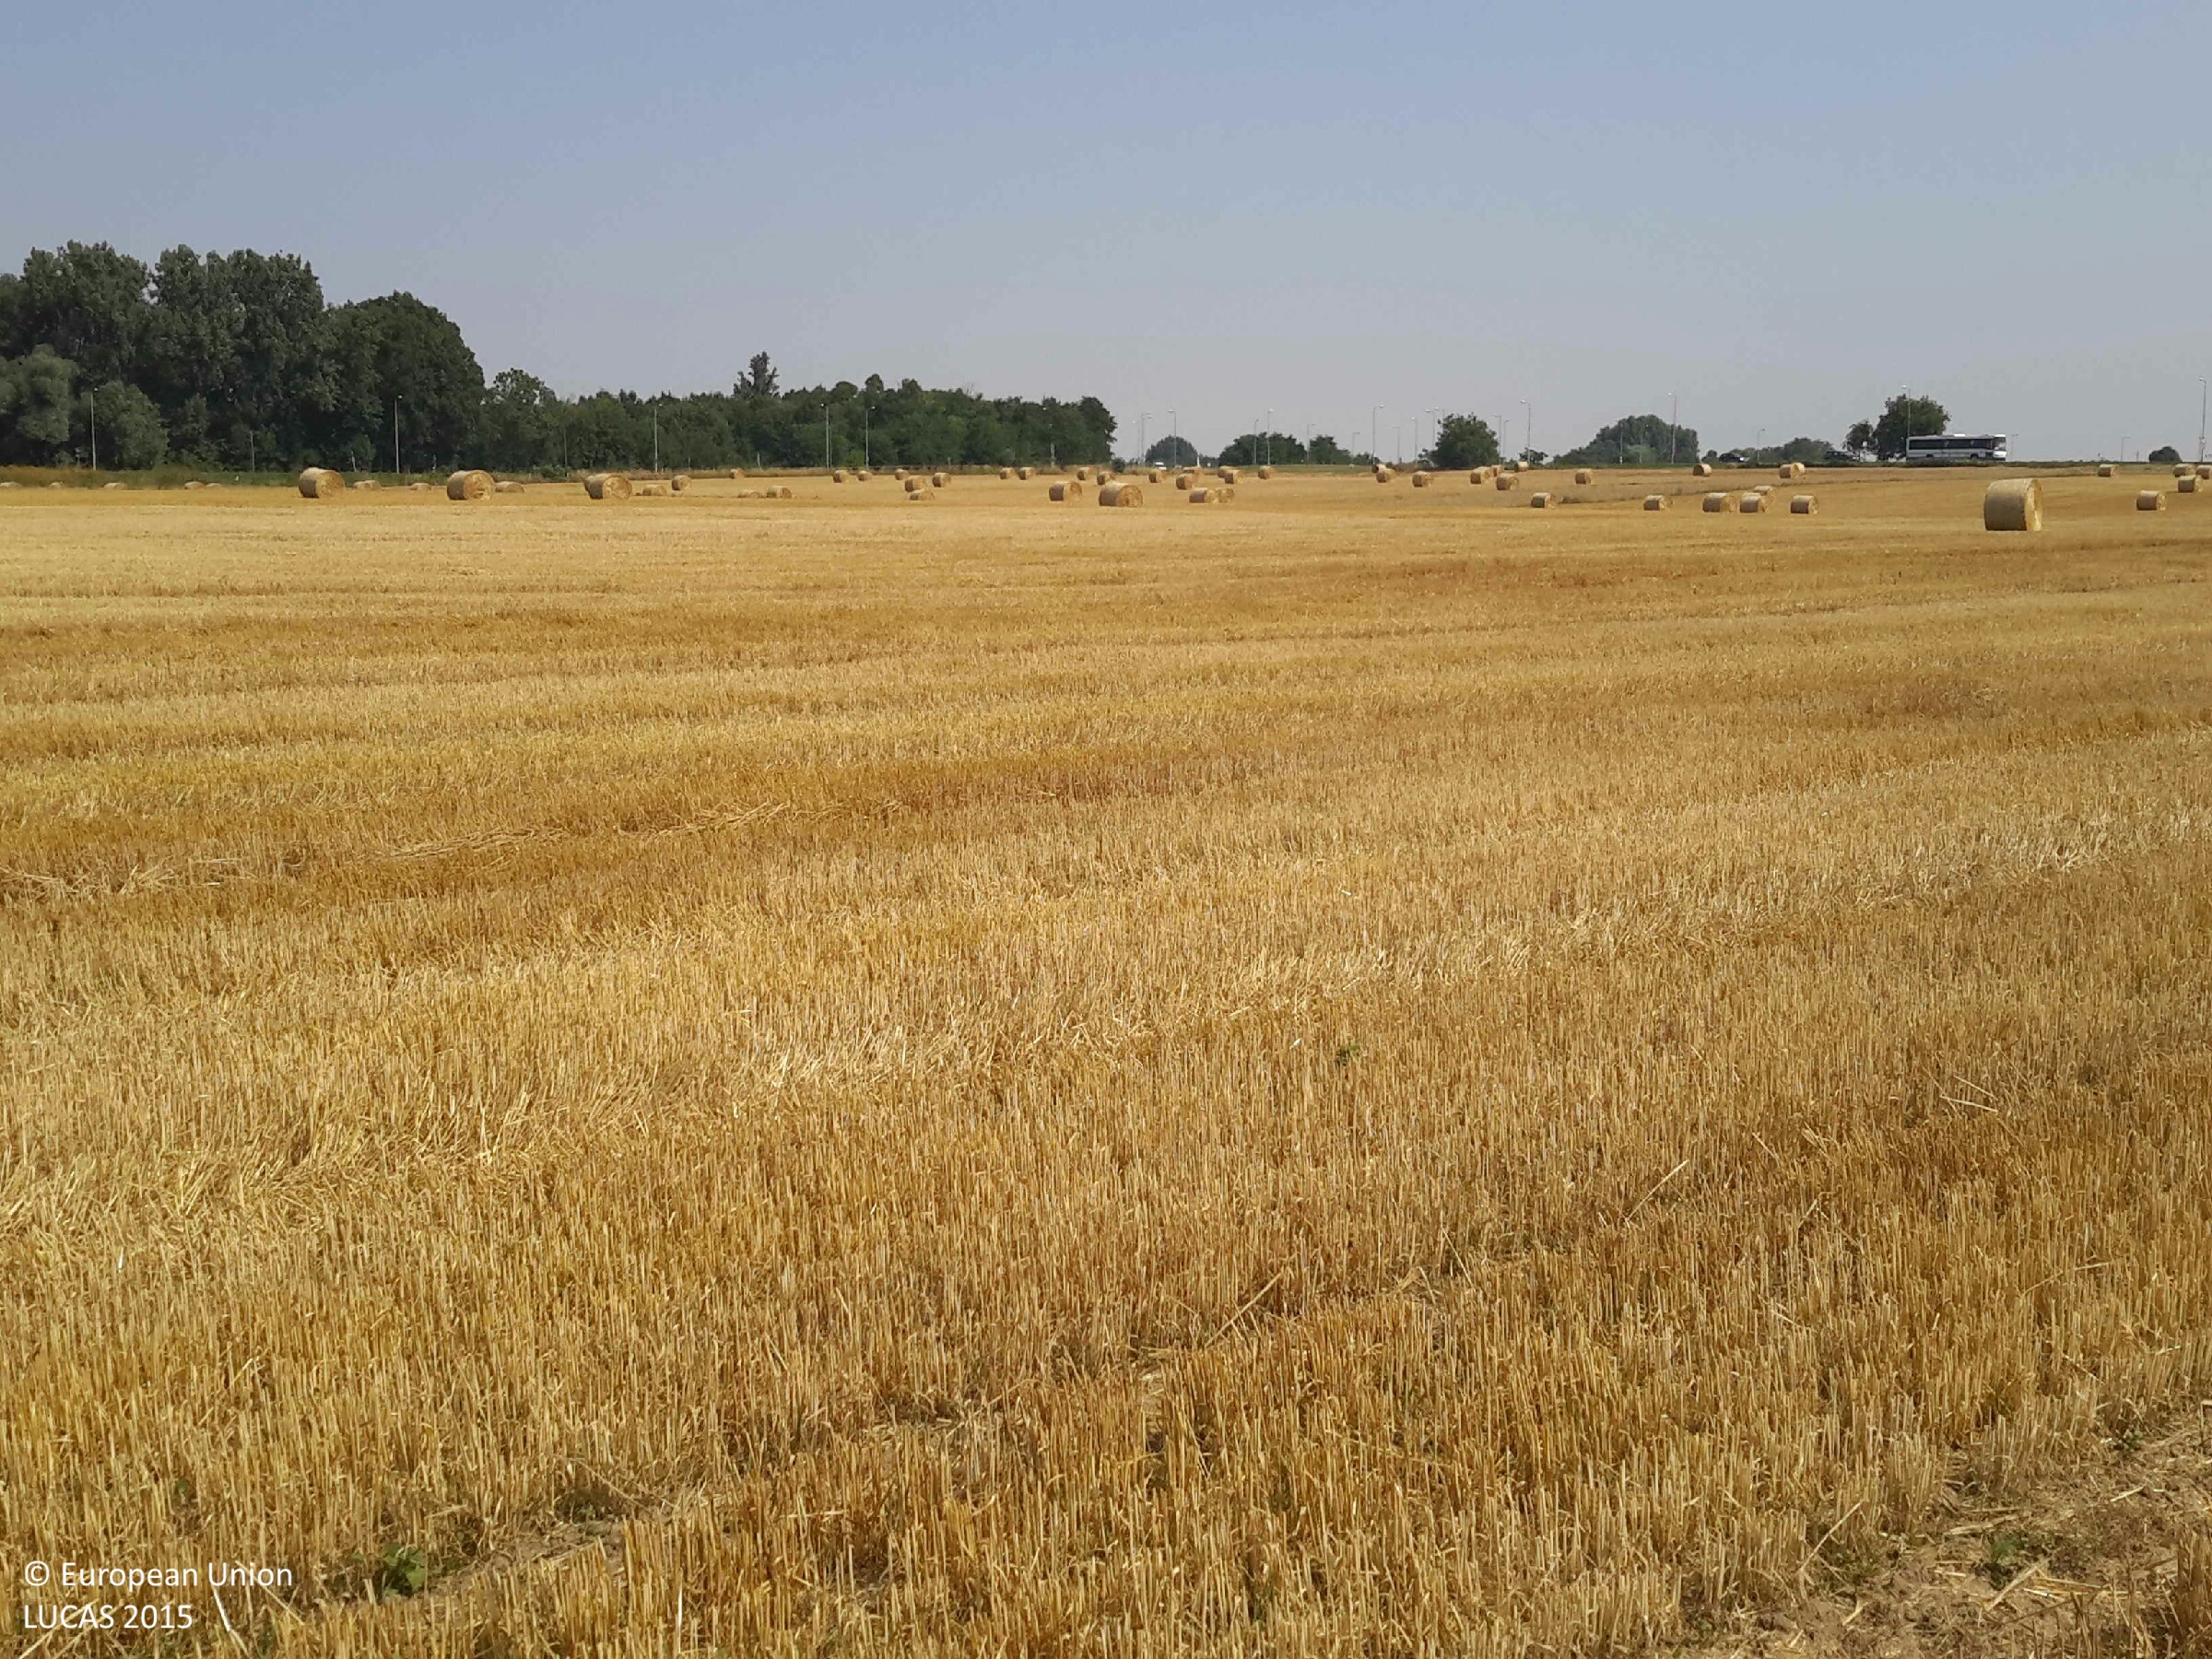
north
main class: Cropland
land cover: Common wheat
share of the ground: 50 - 75 %
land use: Agriculture (excluding fallow land and kitchen gardens)
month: July
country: HU
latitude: 47.4043
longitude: 16.7227
